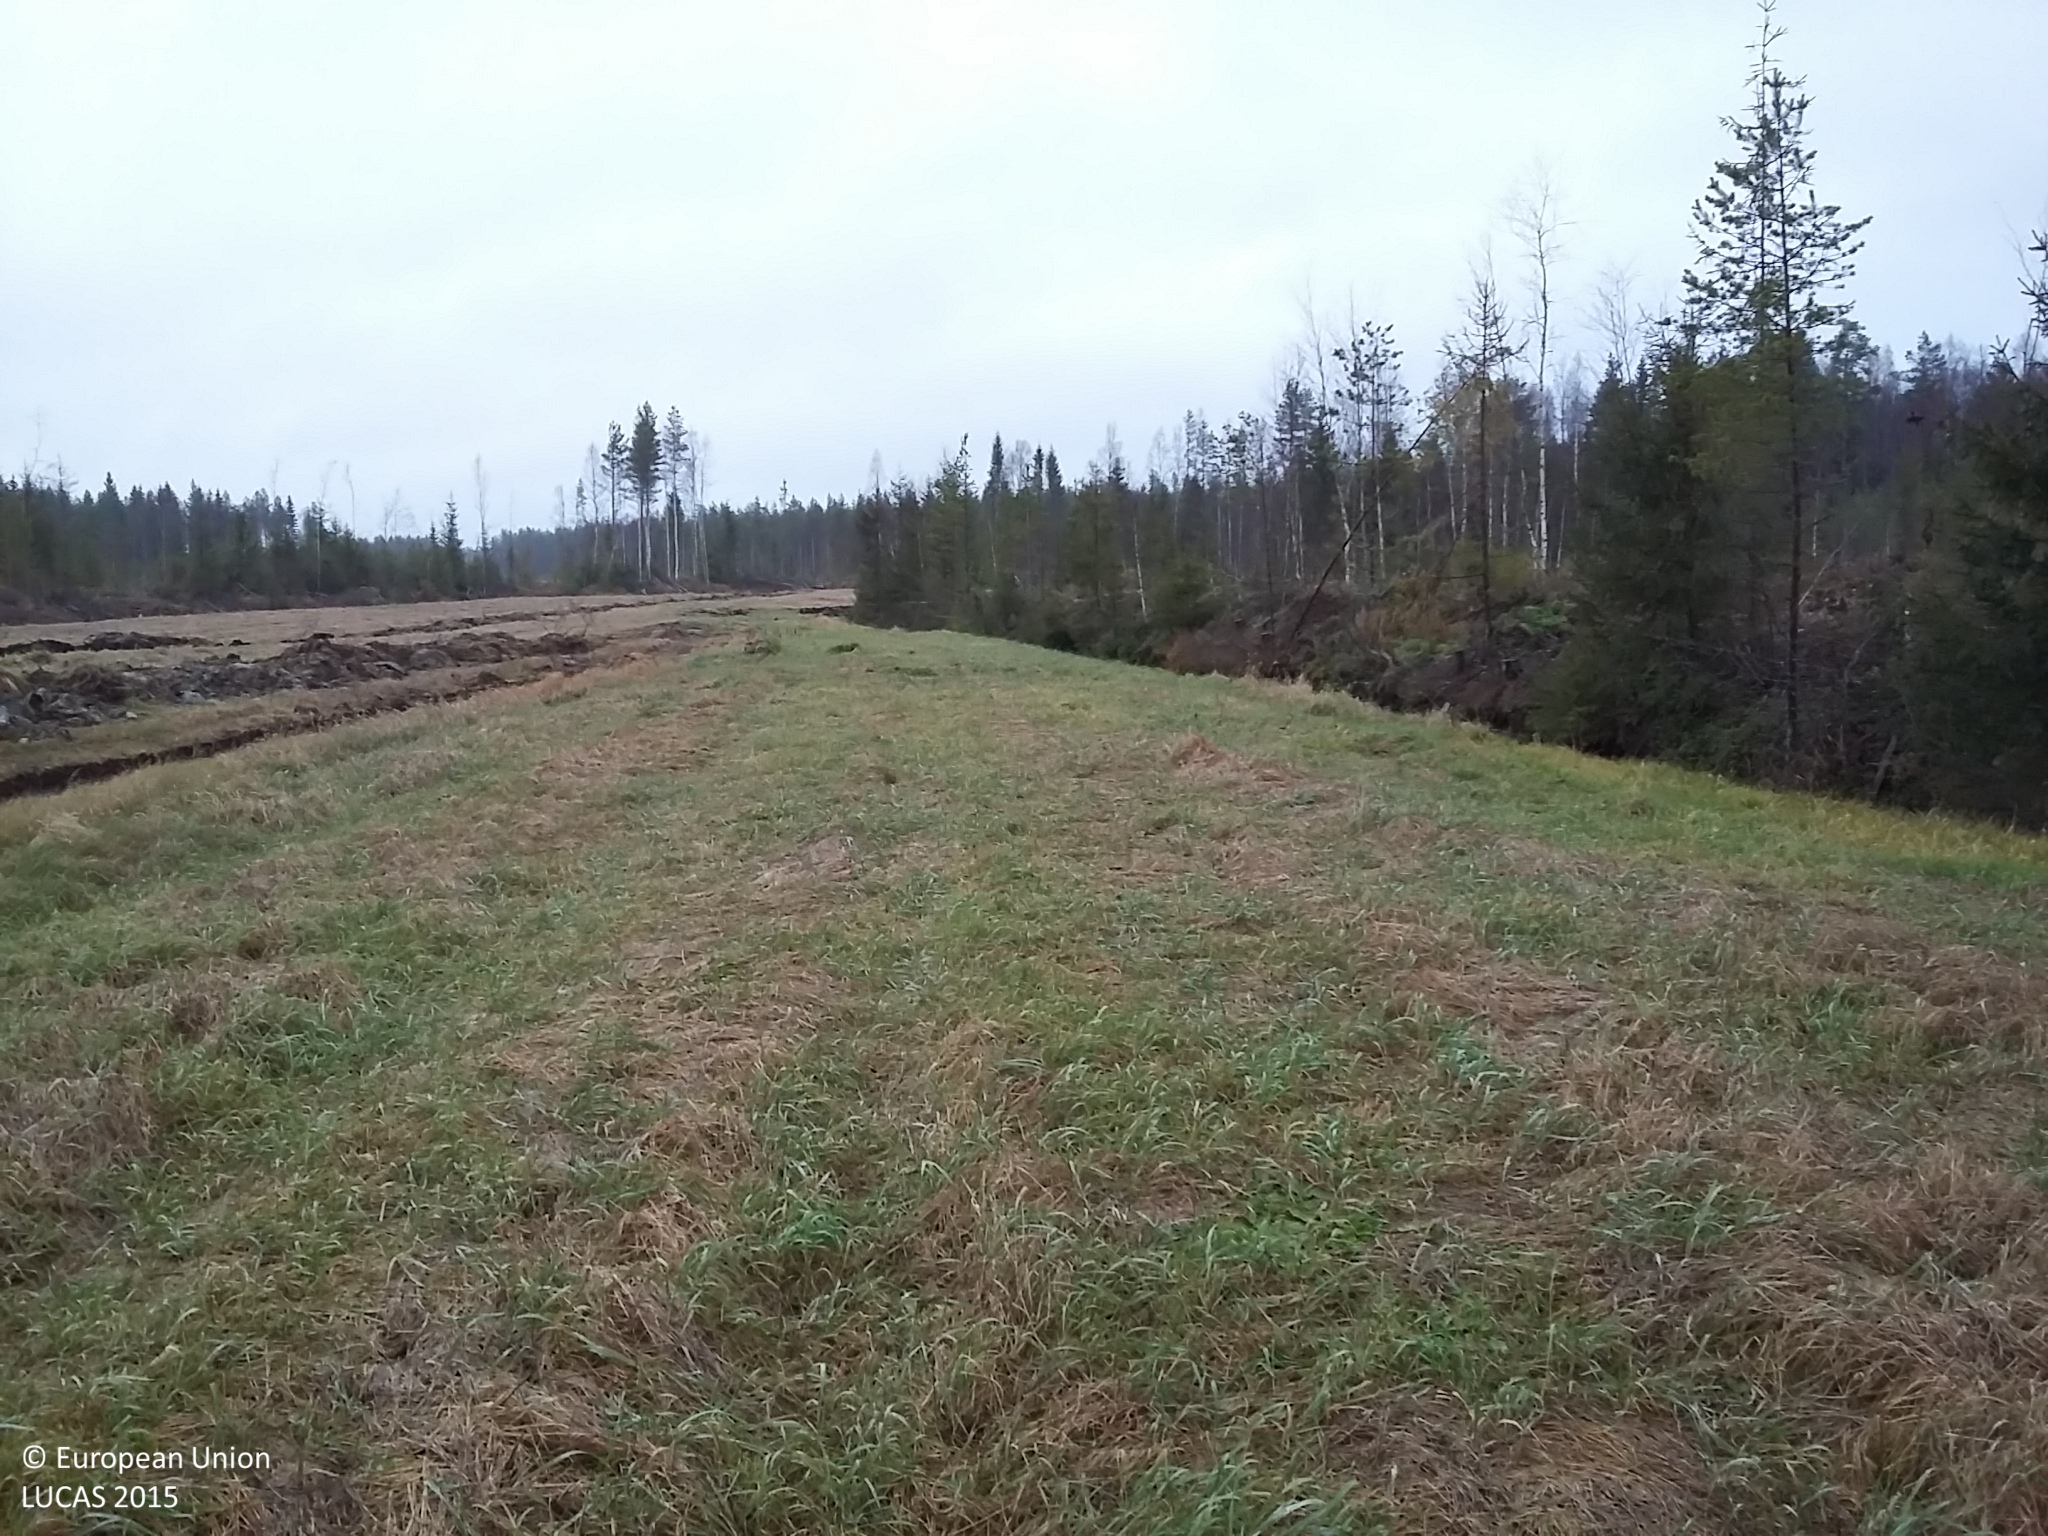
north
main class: Cropland
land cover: Temporary grasslands
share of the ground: > 75 %
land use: Agriculture (excluding fallow land and kitchen gardens)
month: October
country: FI
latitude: 64.4621
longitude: 25.4955
